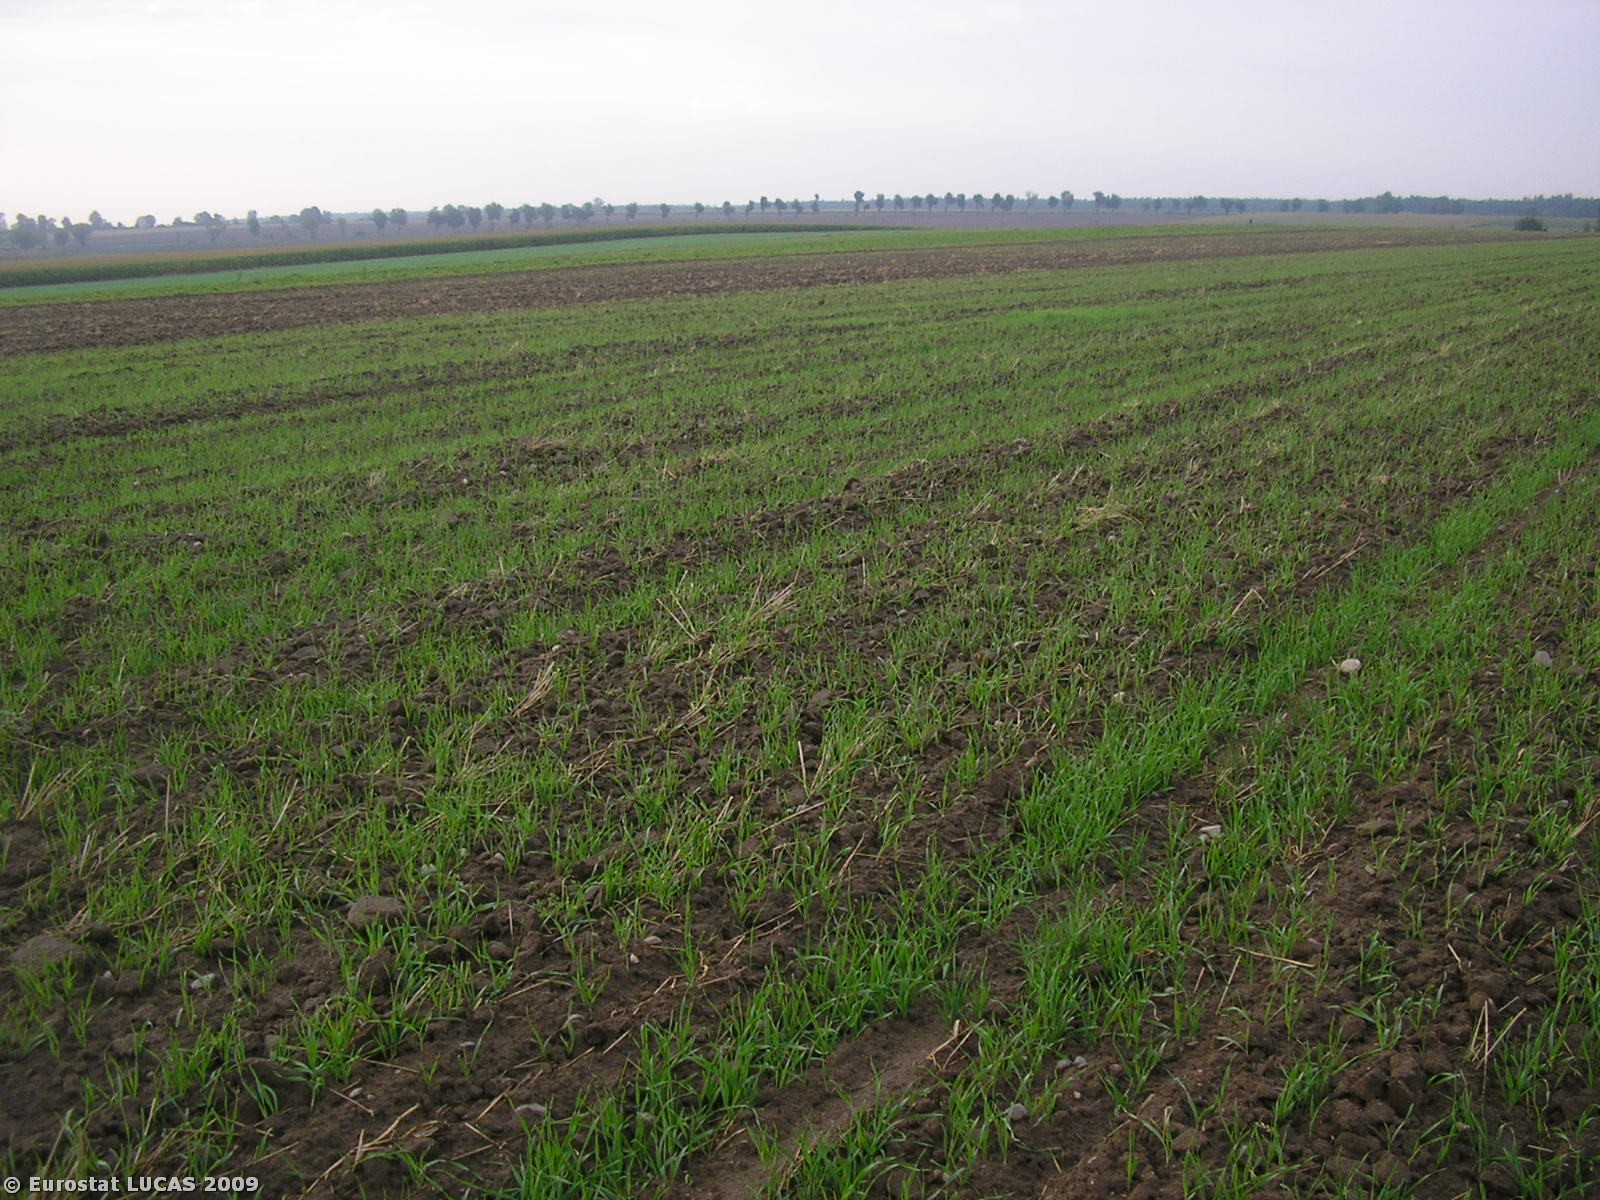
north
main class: Cropland
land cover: Common wheat
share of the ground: < 10 %
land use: Agriculture (excluding fallow land and kitchen gardens)
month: August
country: PL
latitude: 52.3177
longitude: 19.5490
